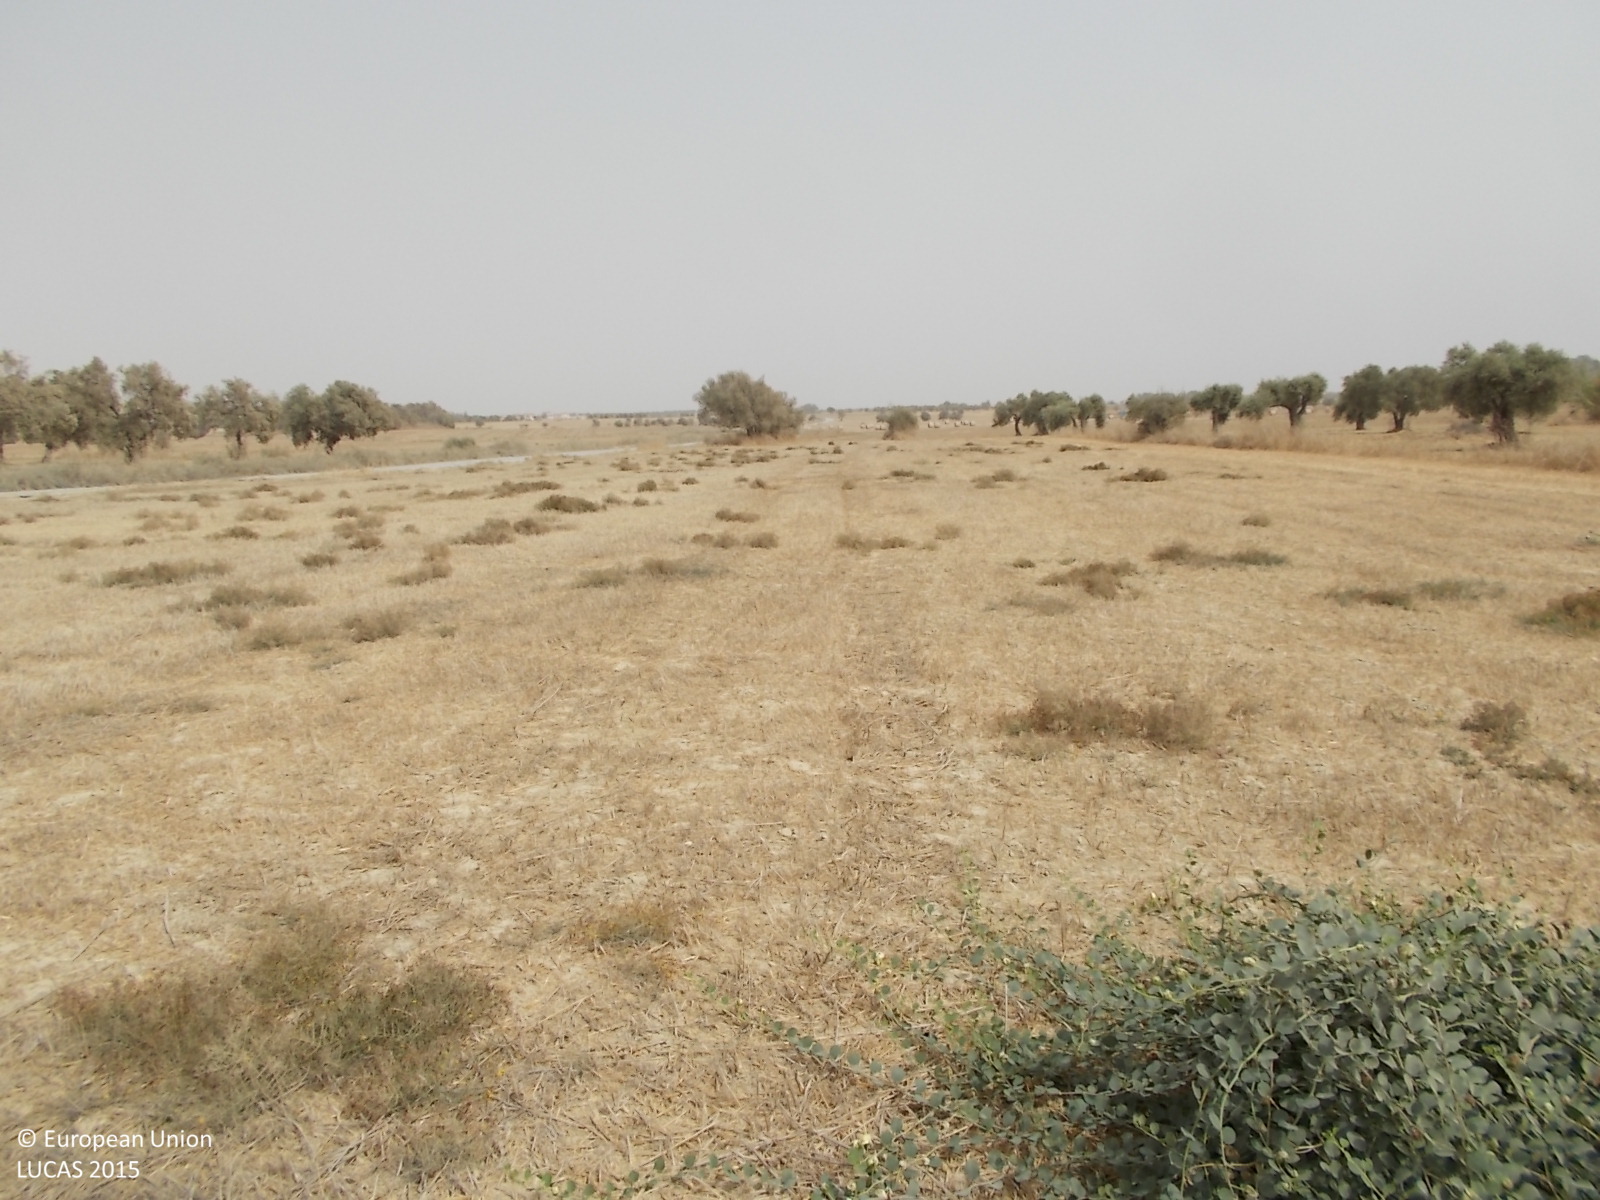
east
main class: Cropland
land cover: Mixed cereals for fodder
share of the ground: < 10 %
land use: Agriculture (excluding fallow land and kitchen gardens)
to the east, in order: Mixed cereals for fodder; Olive groves; Barley; Grass margins; Paved roads, cycling and walking lanes; Grass margins; Barley
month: April
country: CY
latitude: 34.8361
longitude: 33.4904
